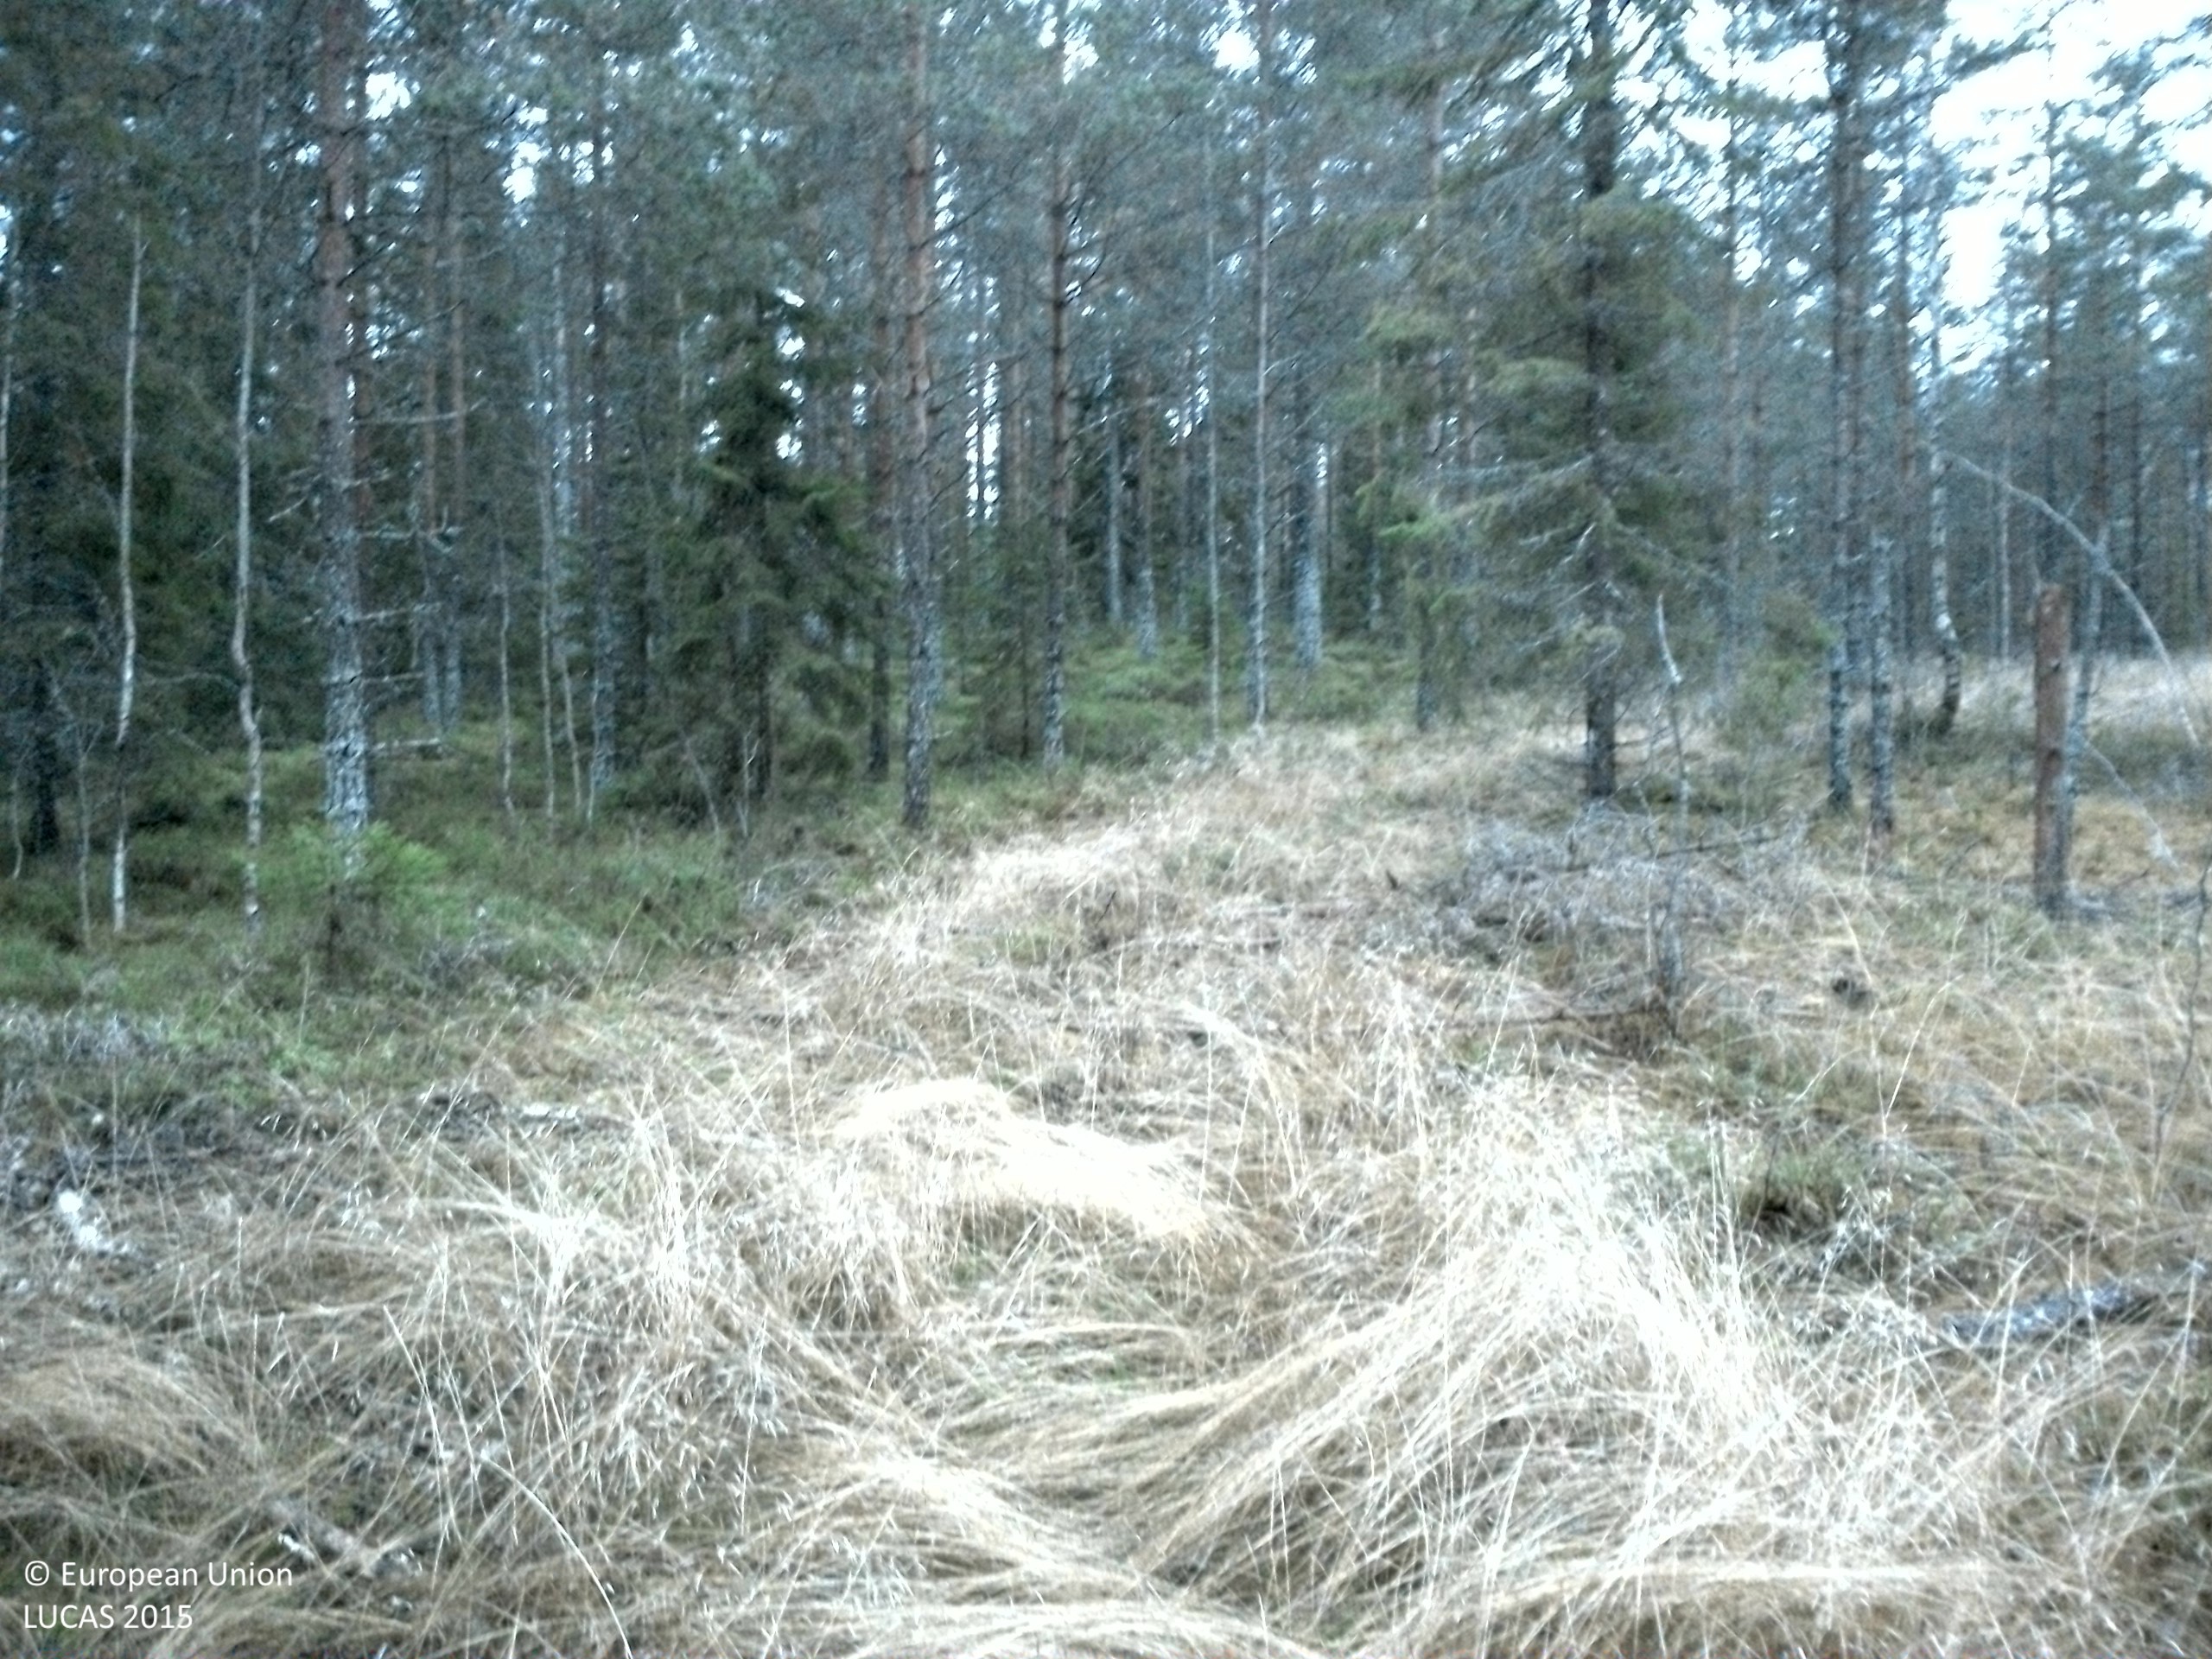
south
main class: Woodland
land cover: Pine dominated coniferous woodland
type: boreal forest
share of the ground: 25 - 50 %
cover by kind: coniferous forest trees 35 %, herbaceous plants 30 %, shrubs 20 %, lichens and mosses 10 %, broadleaved forest trees 5 %
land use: Forestry
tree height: > 5 m
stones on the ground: < 10 %
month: November
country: SE
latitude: 59.8662
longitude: 15.2579
